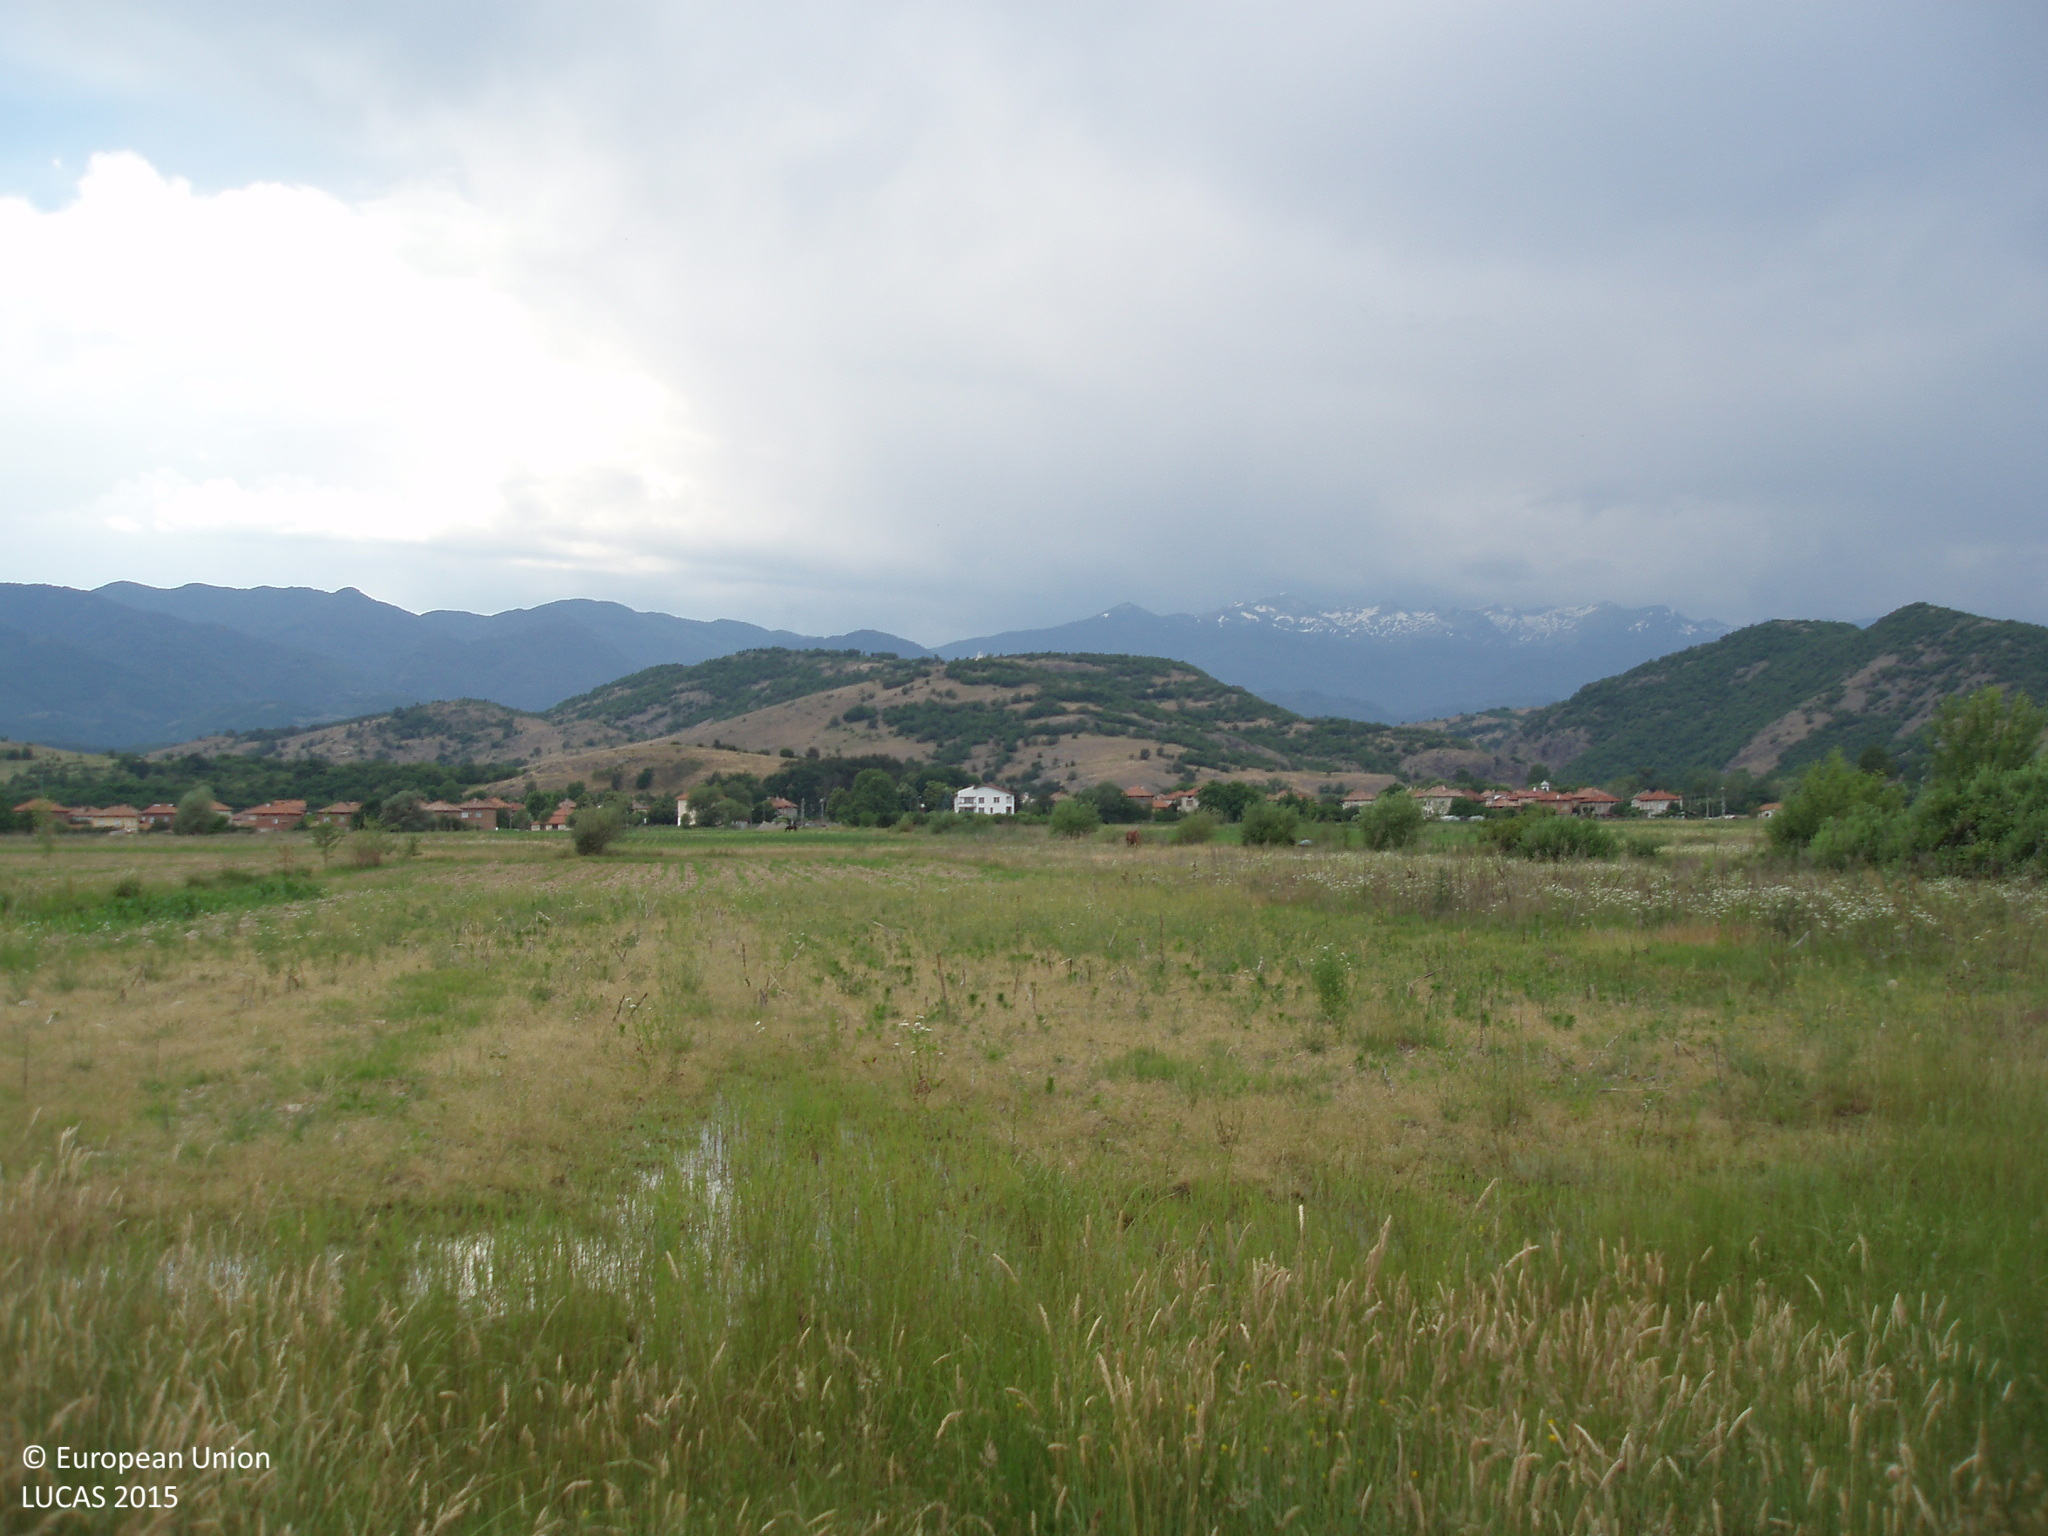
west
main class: Grassland
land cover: Grassland without tree/shrub cover
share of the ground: > 75 %
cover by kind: herbaceous plants 100 %
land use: Agriculture (excluding fallow land and kitchen gardens)
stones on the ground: 10 - 25 %
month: June
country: BG
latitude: 41.6202
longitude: 23.7469
